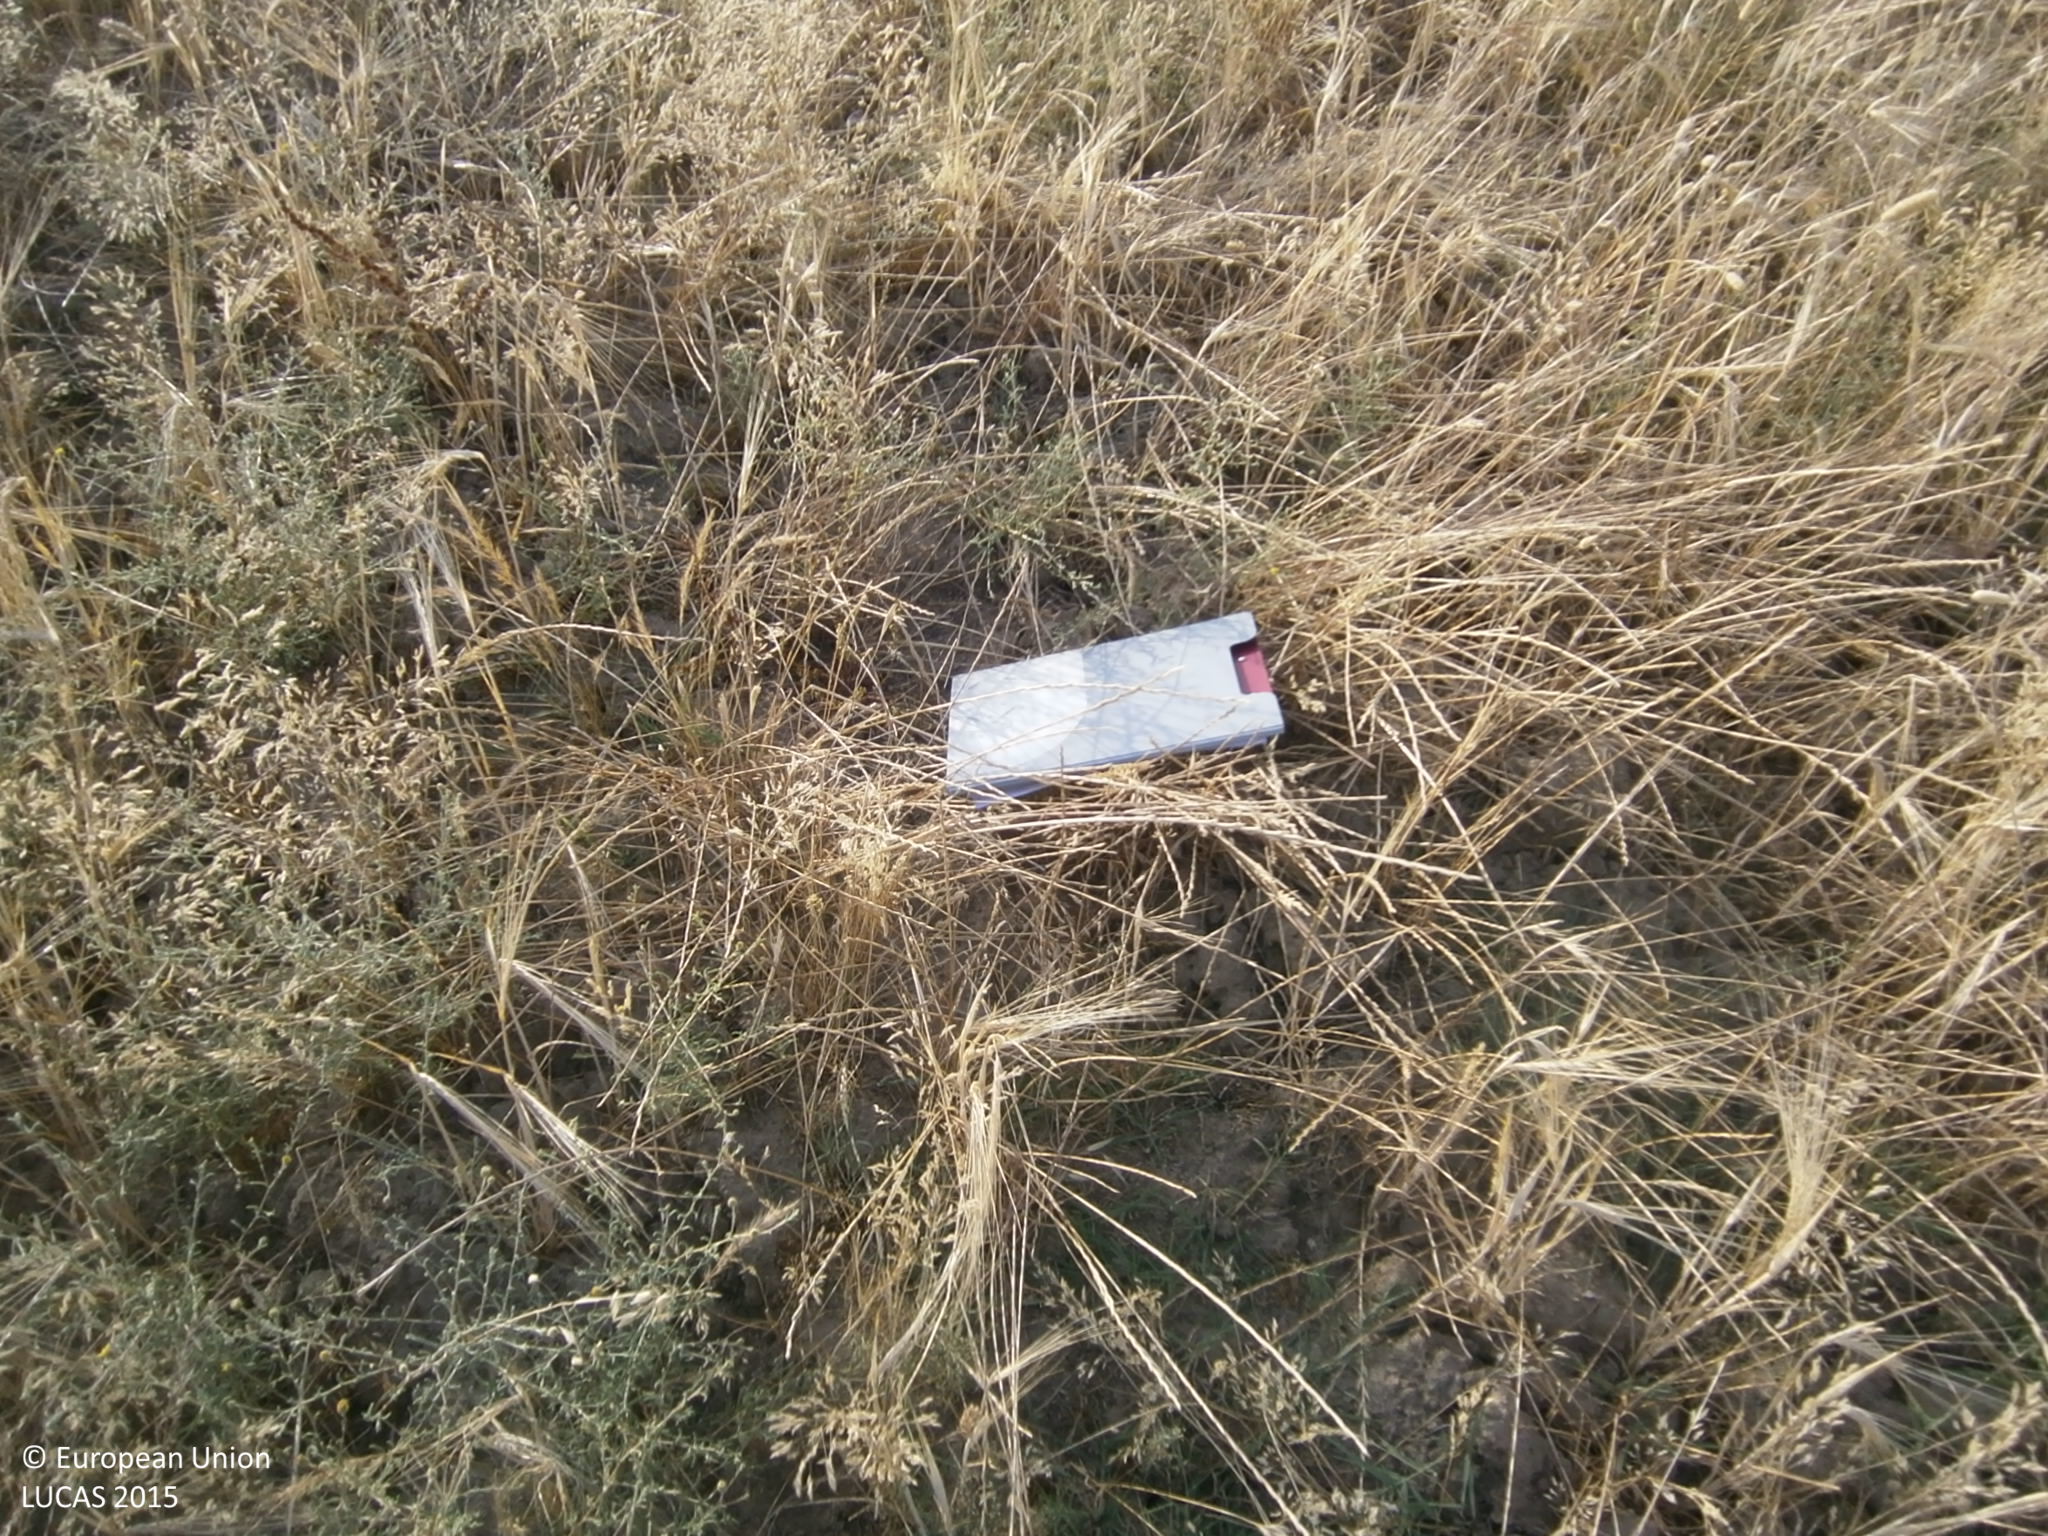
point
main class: Grassland
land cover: Grassland without tree/shrub cover
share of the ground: > 75 %
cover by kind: herbaceous plants 100 %
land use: Agriculture (excluding fallow land and kitchen gardens)
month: June
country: ES
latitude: 38.9013
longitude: -6.2563
